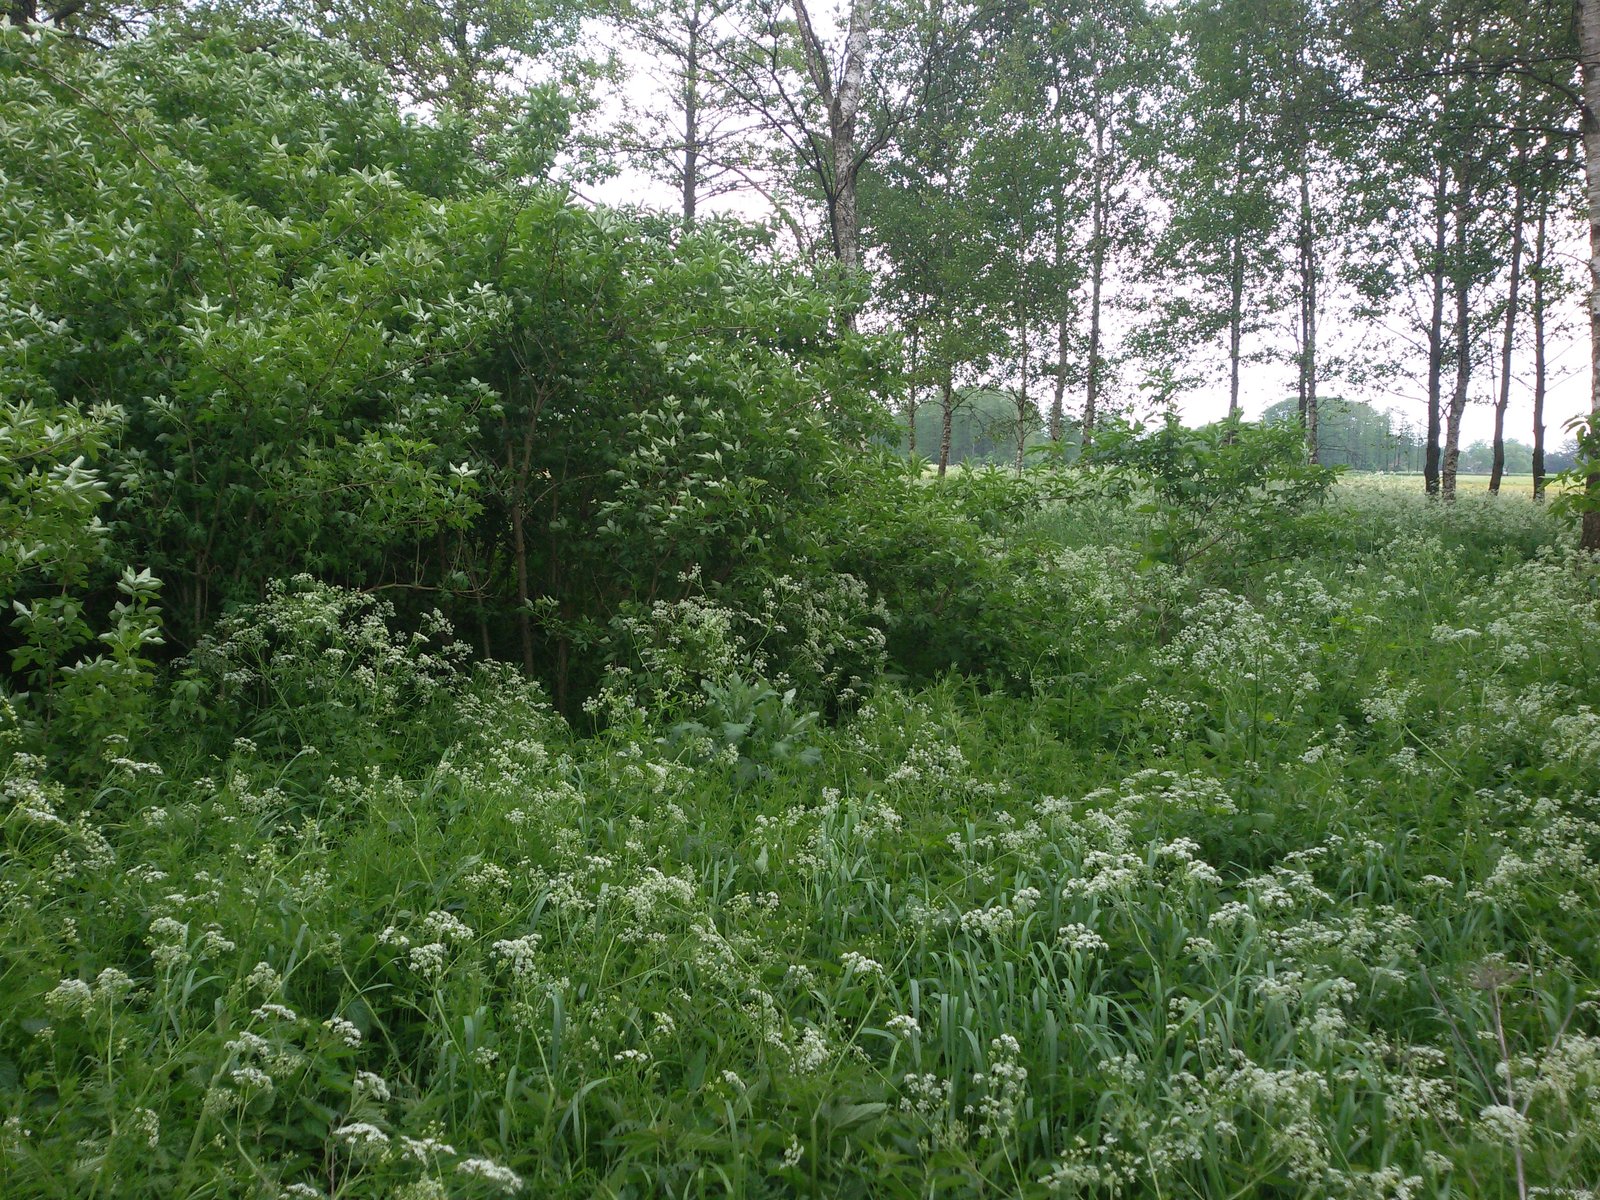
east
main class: Woodland
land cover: Broadleaved woodland
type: mesophytic deciduous forest
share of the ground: 50 - 75 %
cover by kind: broadleaved forest trees 50 %, herbaceous plants 40 %, shrubs 10 %
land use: Forestry
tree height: > 5 m
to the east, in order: Broadleaved woodland; Grassland without tree/shrub cover; Ditches and canals; Grassland without tree/shrub cover
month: May
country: PL
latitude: 53.4420
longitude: 21.0187
